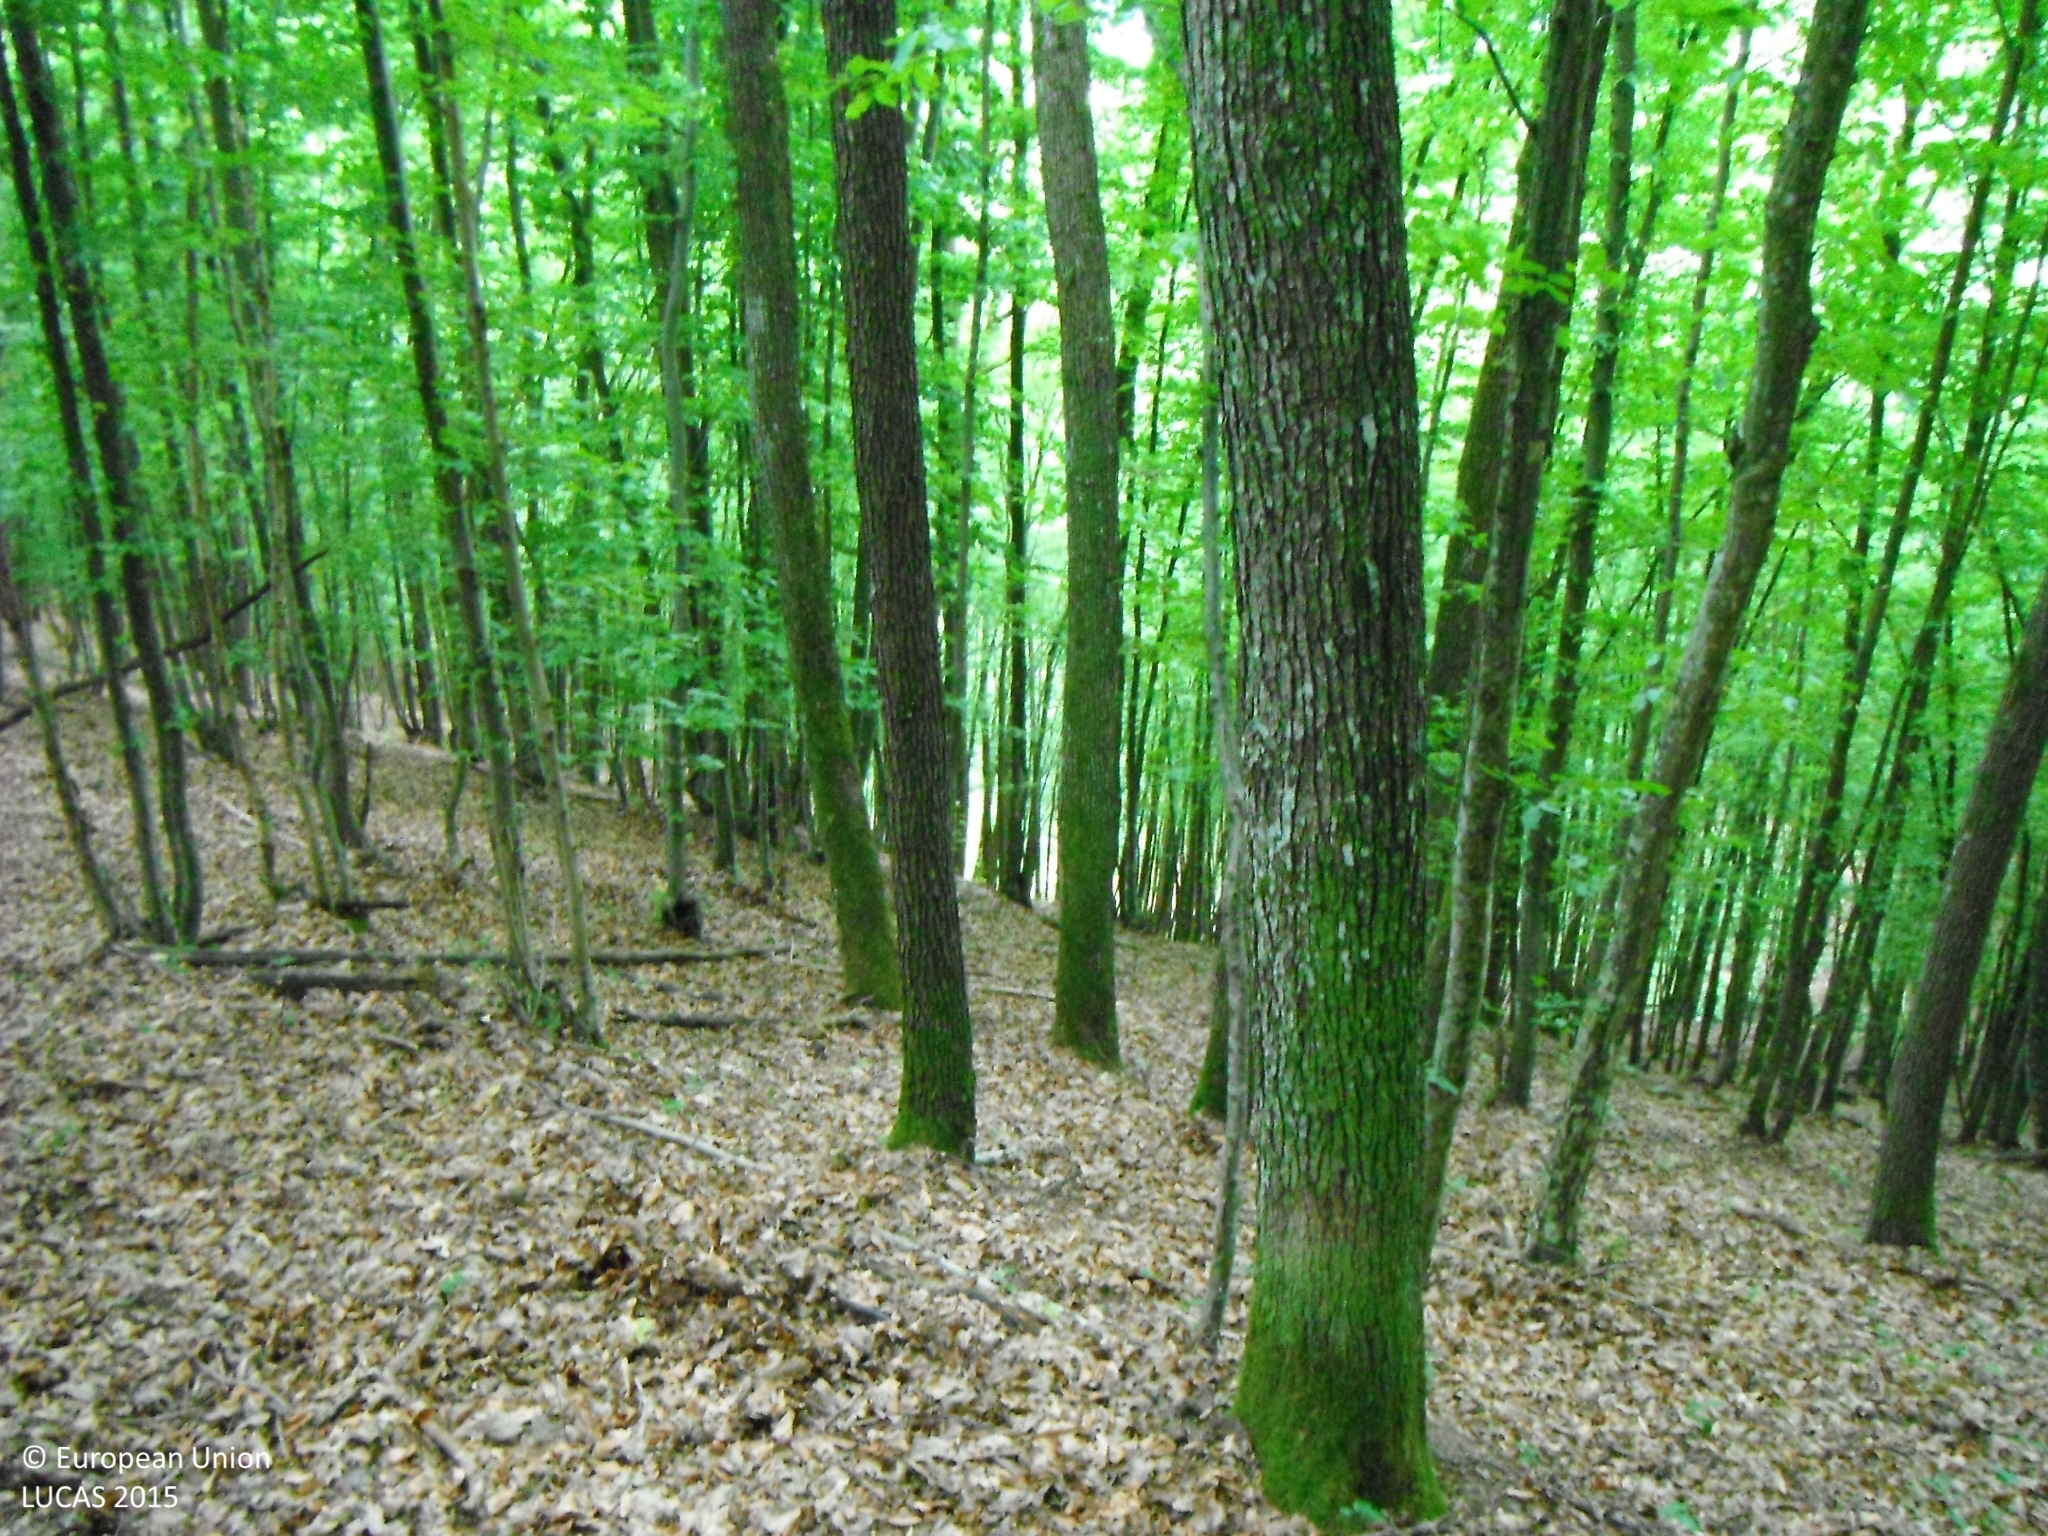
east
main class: Woodland
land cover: Broadleaved woodland
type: mesophytic deciduous forest
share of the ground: > 75 %
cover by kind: broadleaved forest trees 95 %, unconsolidated bare surface 5 %
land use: Forestry
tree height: > 5 m
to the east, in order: Broadleaved woodland; Tracks; Broadleaved woodland; Rivers and streams; Broadleaved woodland; Tracks; Broadleaved woodland
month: June
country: SK
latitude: 48.5338
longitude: 20.1476
